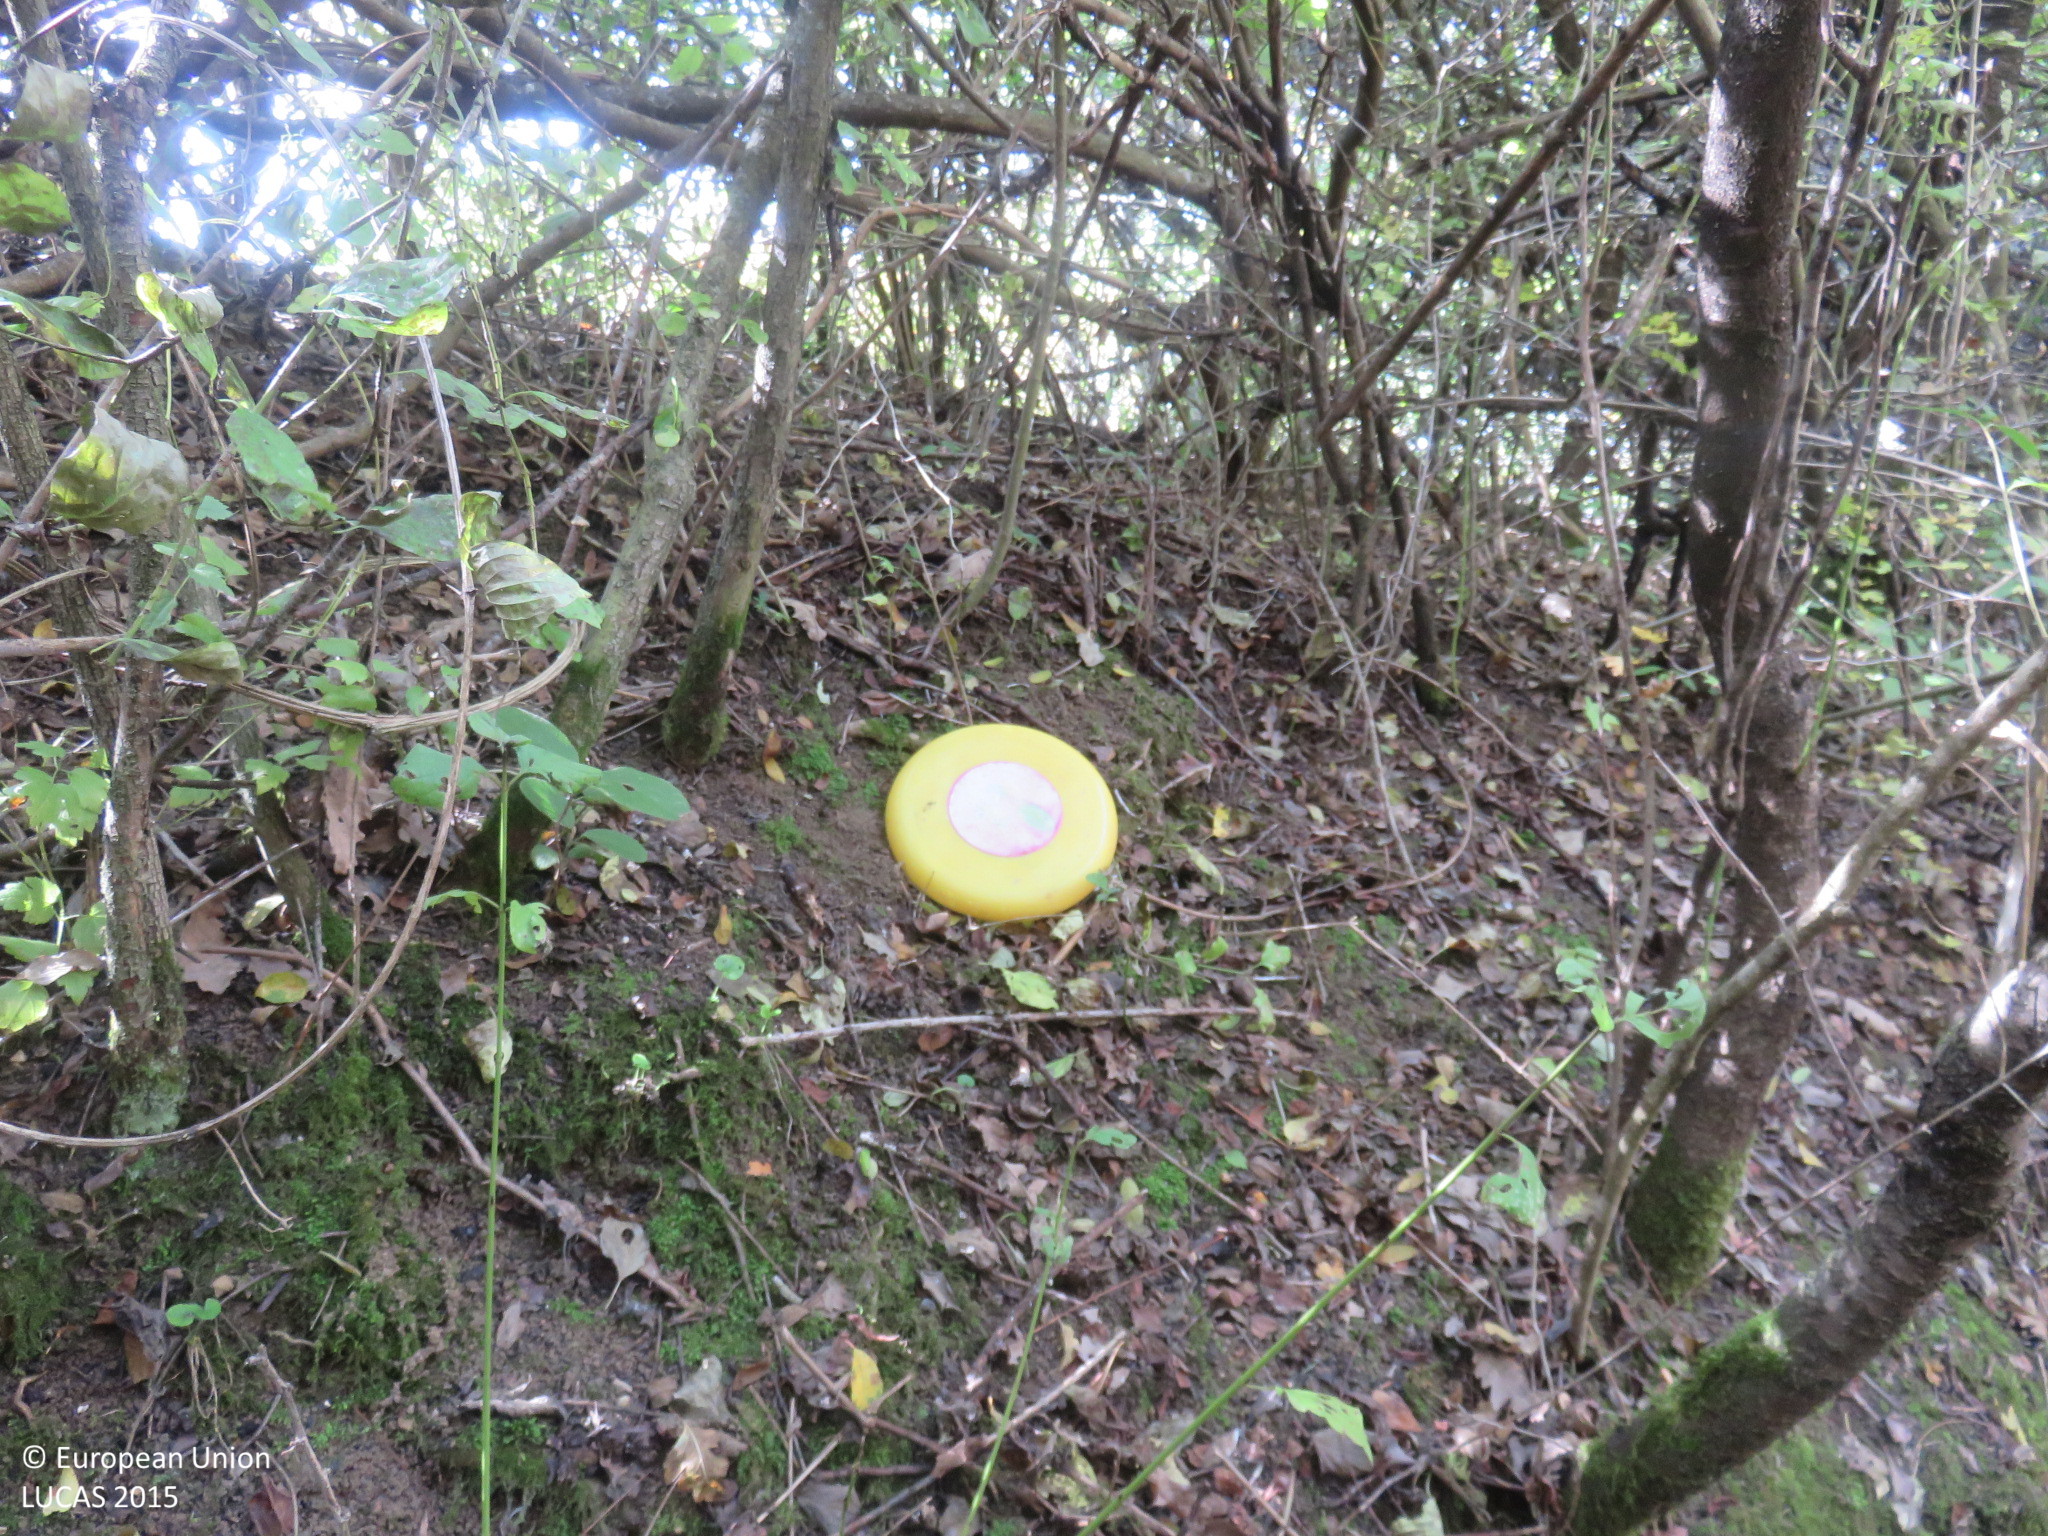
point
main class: Woodland
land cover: Broadleaved woodland
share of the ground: > 75 %
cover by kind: broadleaved forest trees 70 %, shrubs 30 %
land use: Semi-natural and natural areas not in use
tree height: < 5 m
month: October
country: BG
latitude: 42.9657
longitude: 24.8355
